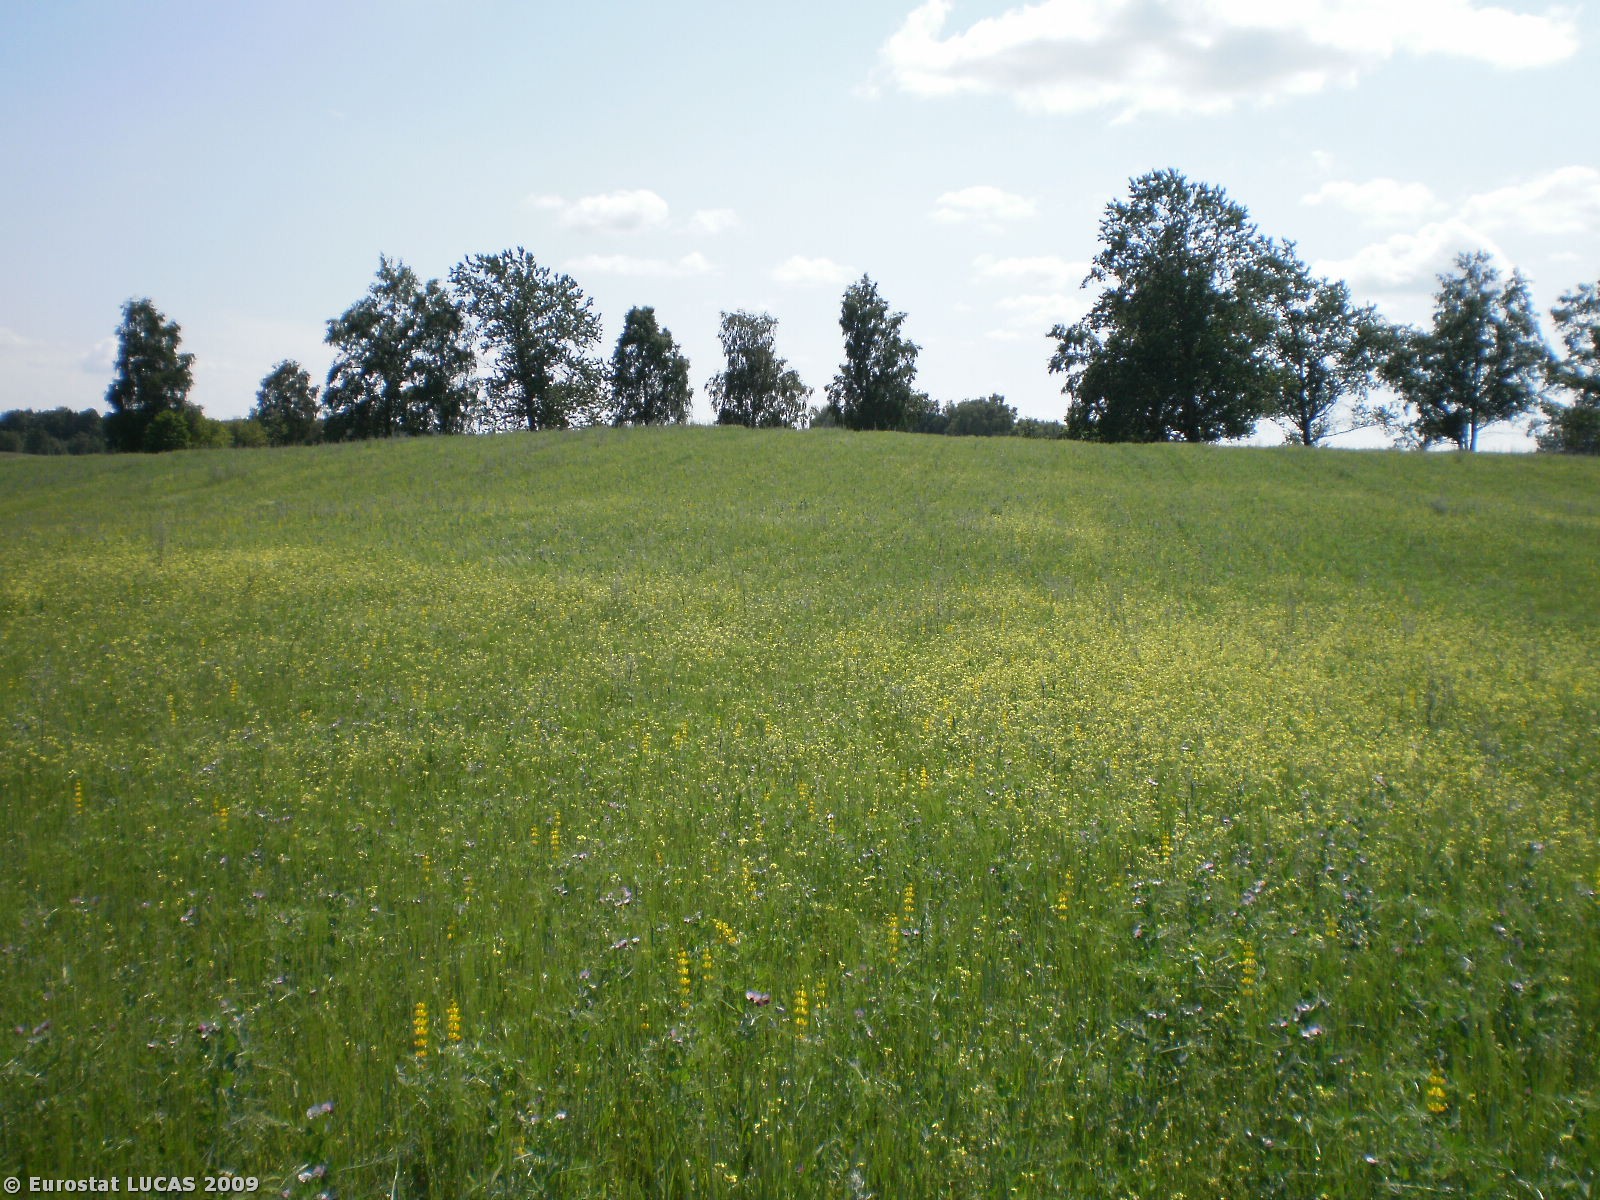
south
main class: Cropland
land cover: Mixed cereals for fodder
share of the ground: > 75 %
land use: Agriculture (excluding fallow land and kitchen gardens)
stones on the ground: < 10 %
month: February
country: PL
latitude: 54.1412
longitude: 17.2501
